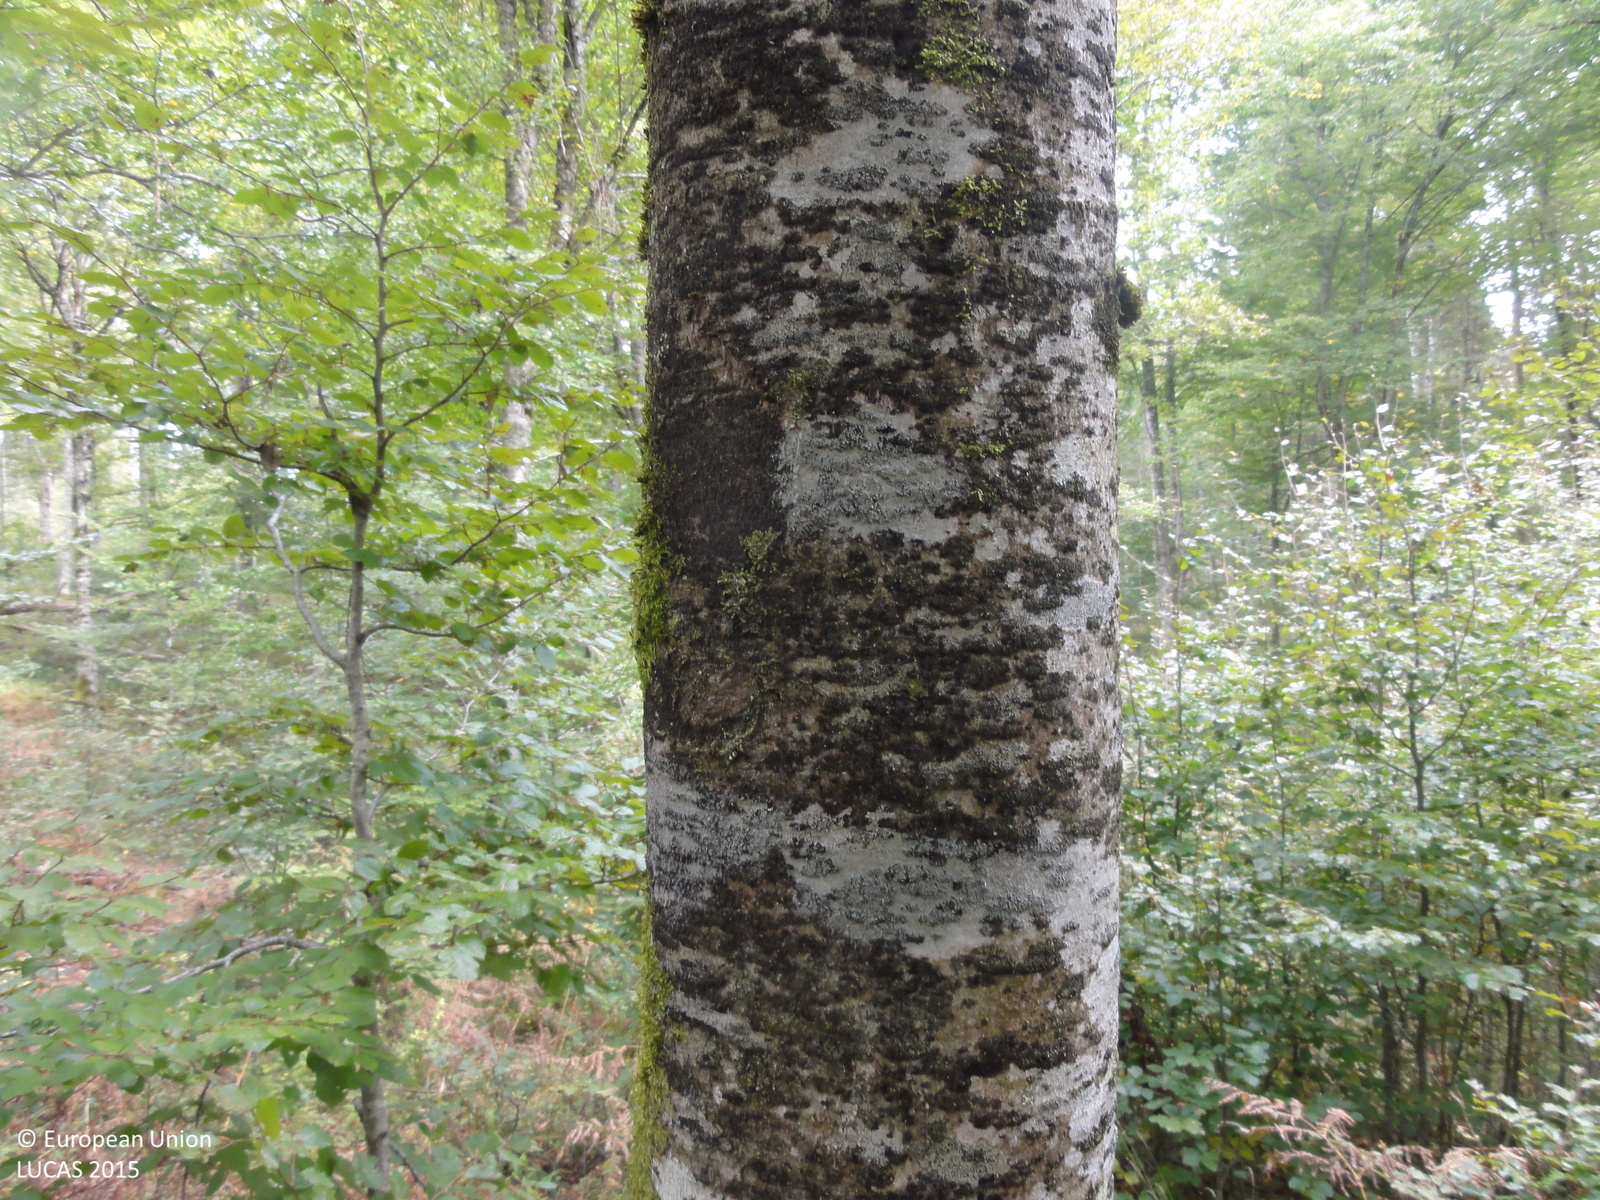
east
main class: Woodland
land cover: Broadleaved woodland
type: beech forest
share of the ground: > 75 %
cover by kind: broadleaved forest trees 85 %, shrubs 5 %, herbaceous plants 5 %
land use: Forestry
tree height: > 5 m
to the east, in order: Broadleaved woodland; Tracks; Broadleaved woodland; Shrubland with sparse tree cover; Tracks; Broadleaved woodland
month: September
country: SI
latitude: 45.5495
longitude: 14.9784
